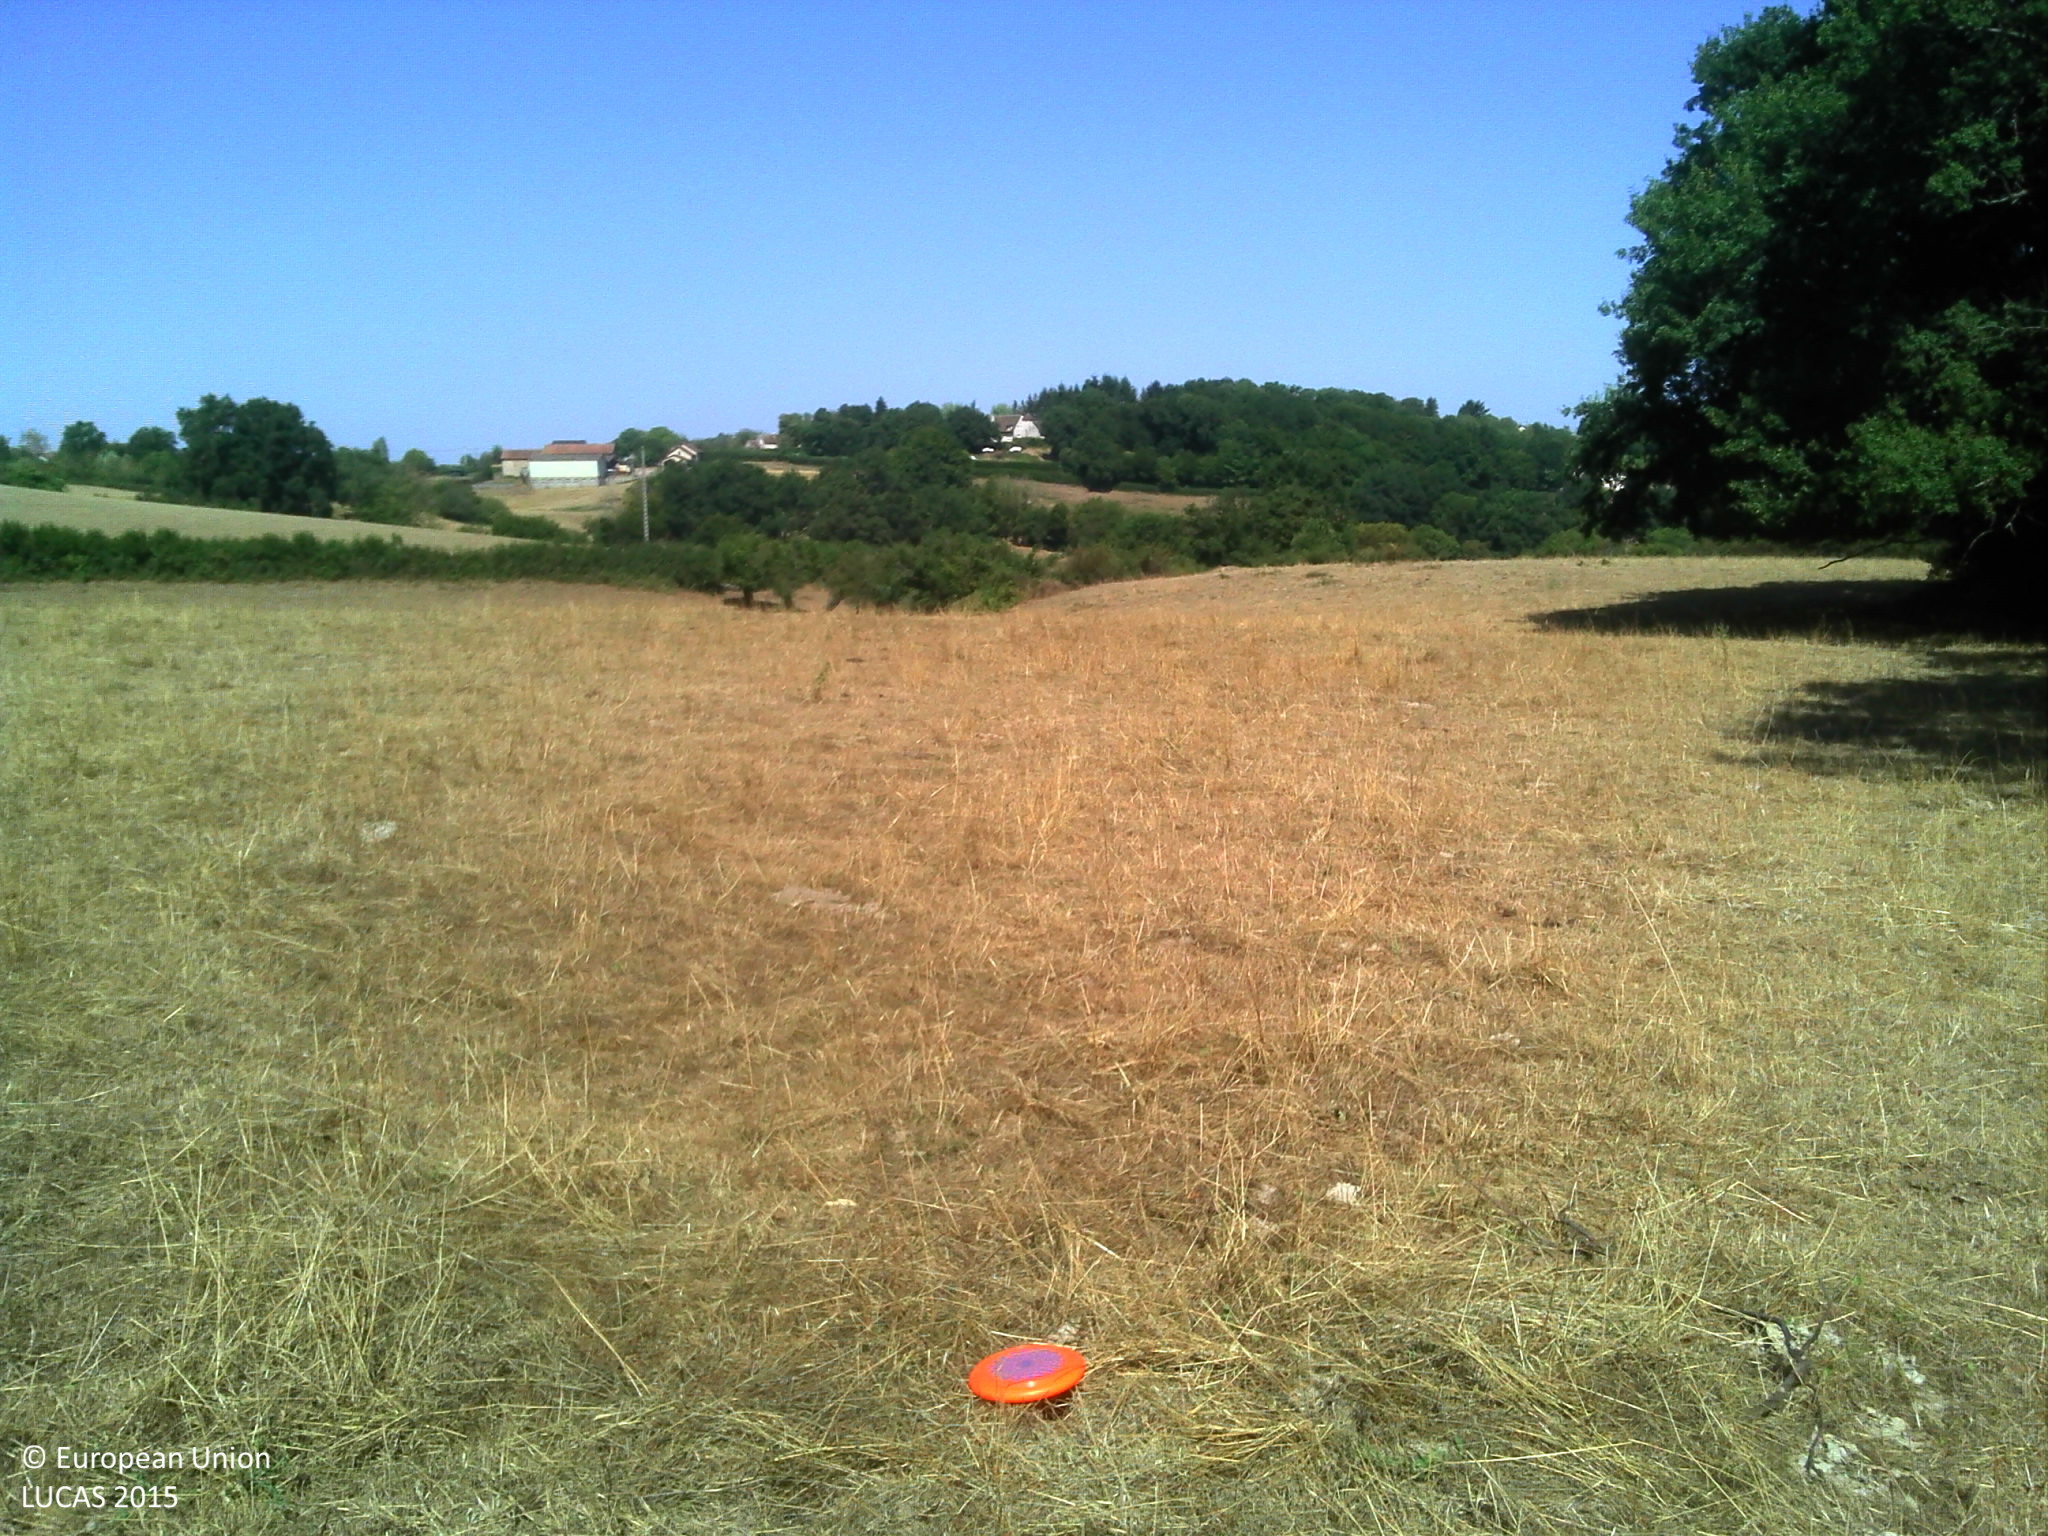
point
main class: Grassland
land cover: Grassland without tree/shrub cover
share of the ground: > 75 %
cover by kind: herbaceous plants 100 %
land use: Agriculture (excluding fallow land and kitchen gardens)
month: August
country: FR
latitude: 46.6555
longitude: 4.3948
